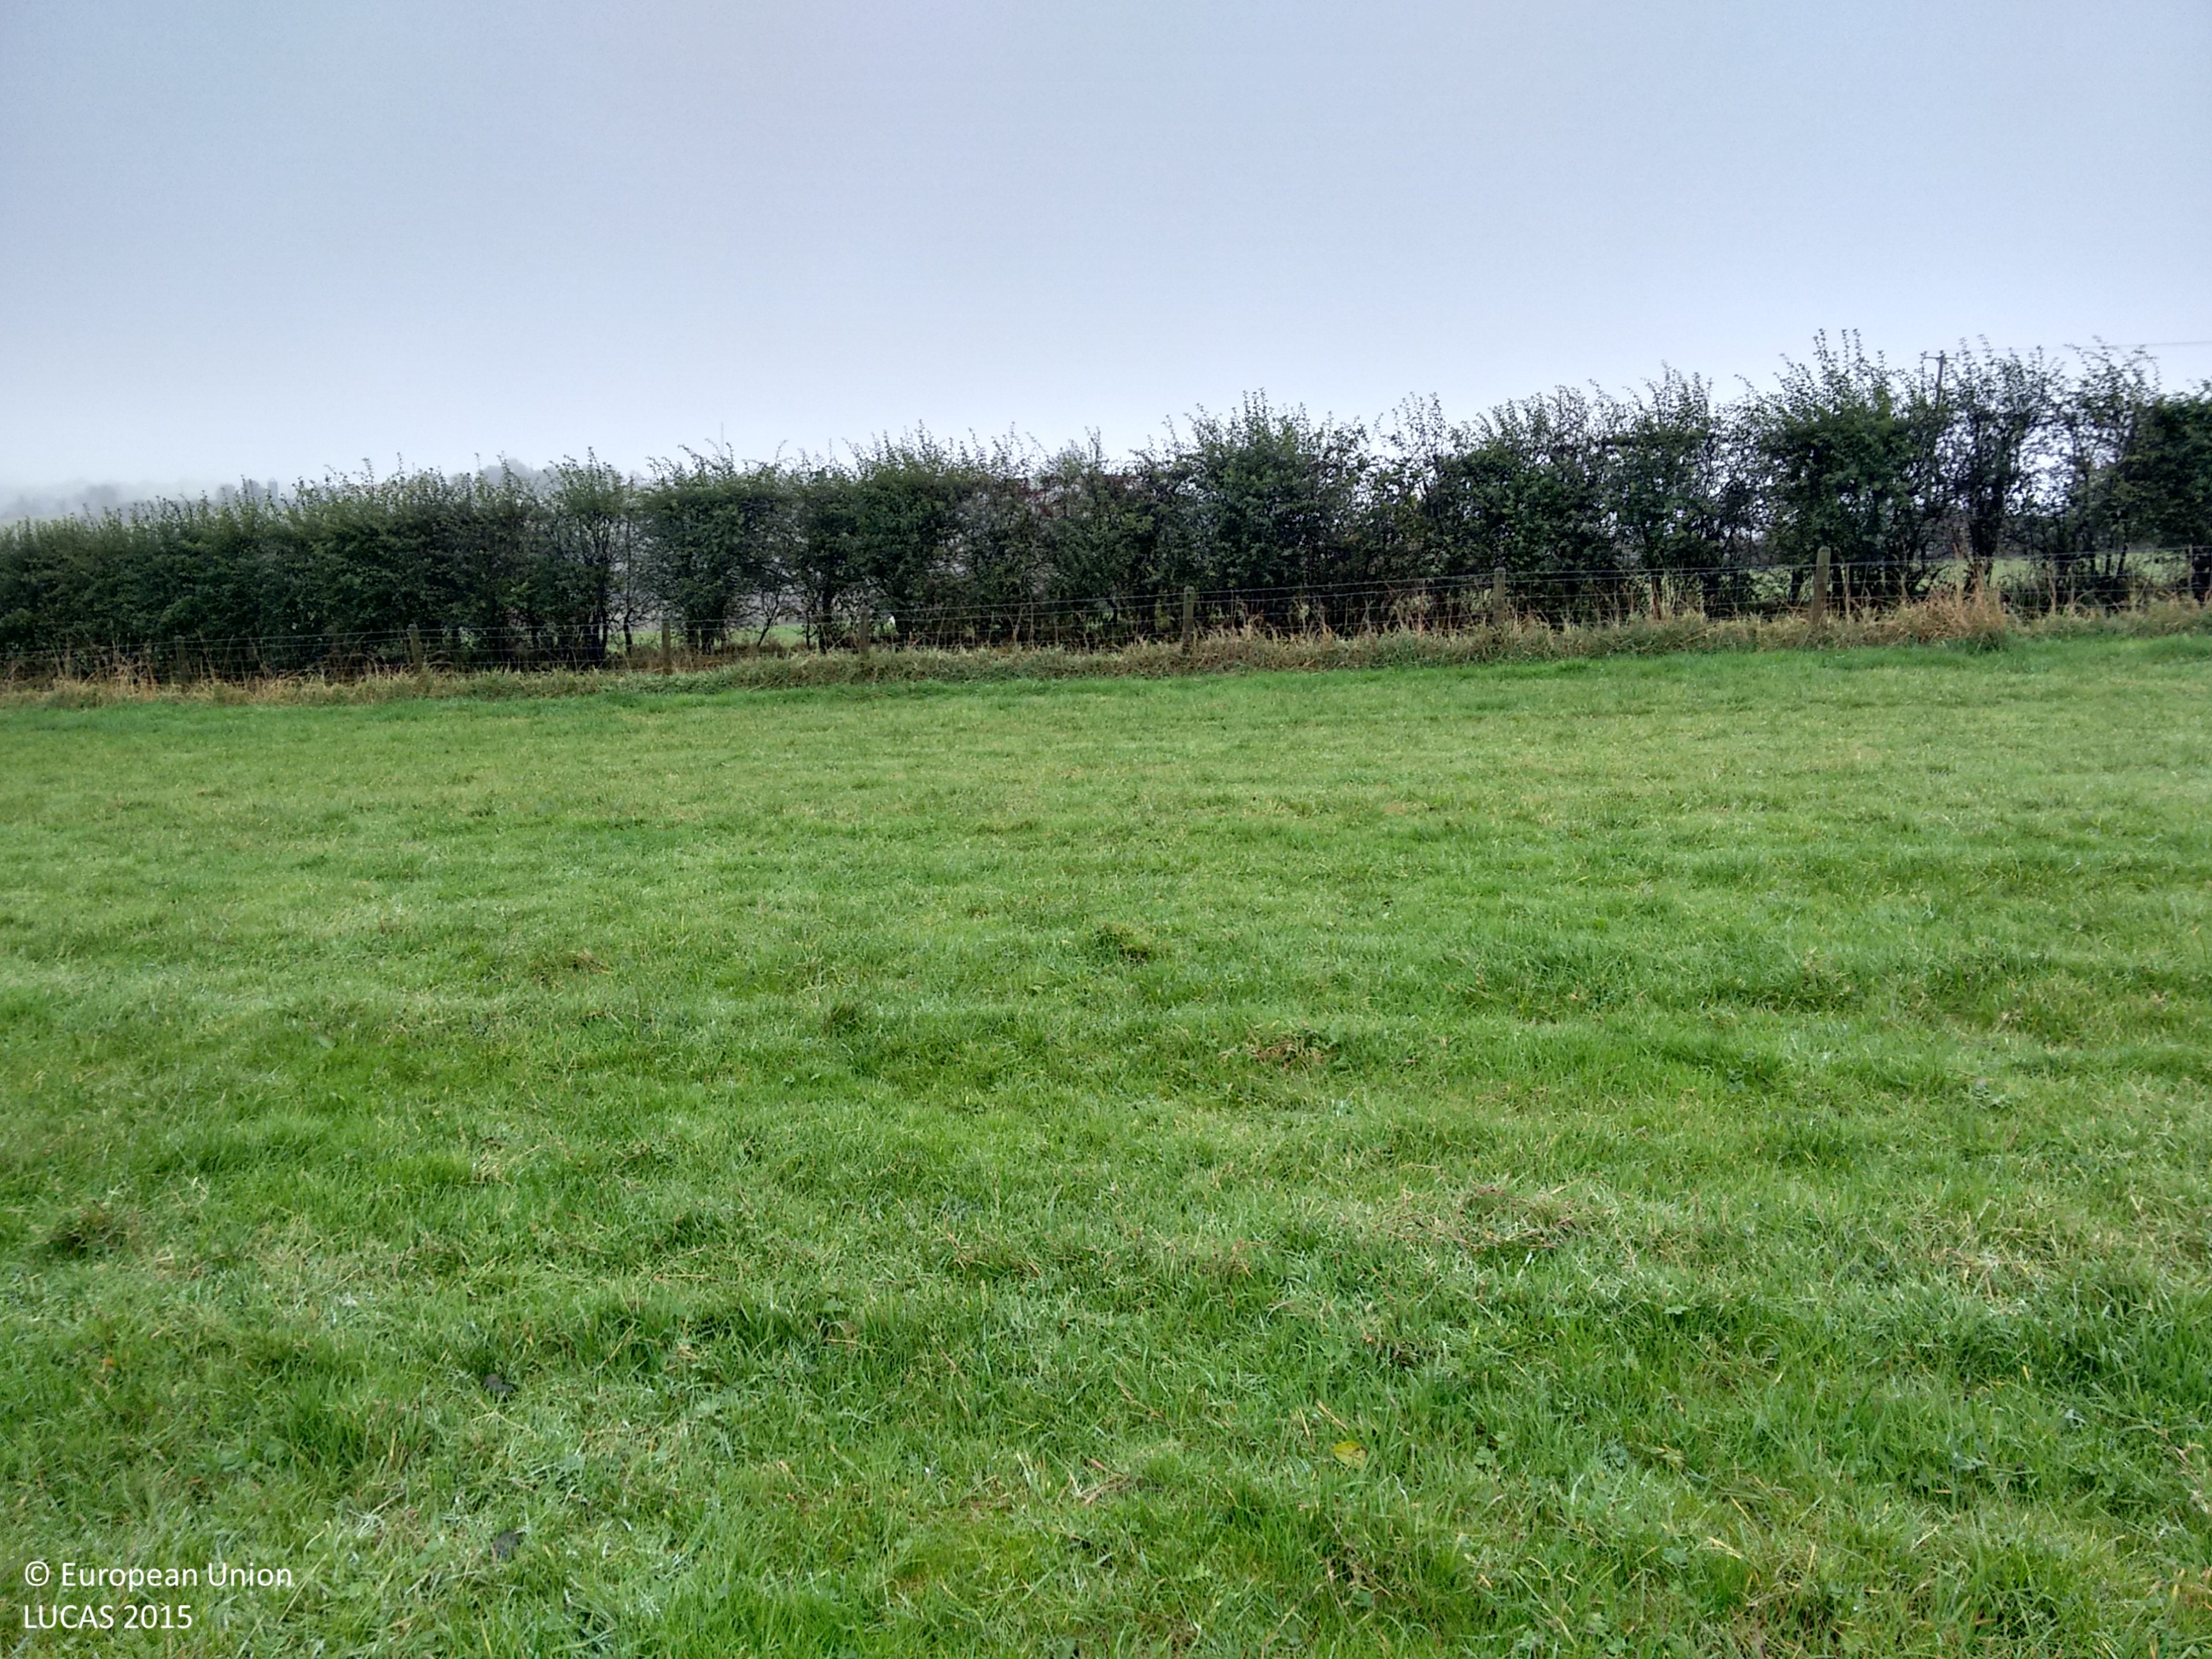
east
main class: Grassland
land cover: Grassland without tree/shrub cover
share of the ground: > 75 %
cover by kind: herbaceous plants 100 %
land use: Agriculture (excluding fallow land and kitchen gardens)
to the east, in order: Grassland without tree/shrub cover; Fences; Grass margins; Tracks; Grass margins; Managed hedges; Grassland without tree/shrub cover; Fences; Managed hedges; Grassland without tree/shrub cover; Fences; Managed hedges; Grassland without tree/shrub cover; Fences; Grassland without tree/shrub cover
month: October
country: GB
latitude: 54.5222
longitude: -7.5379
